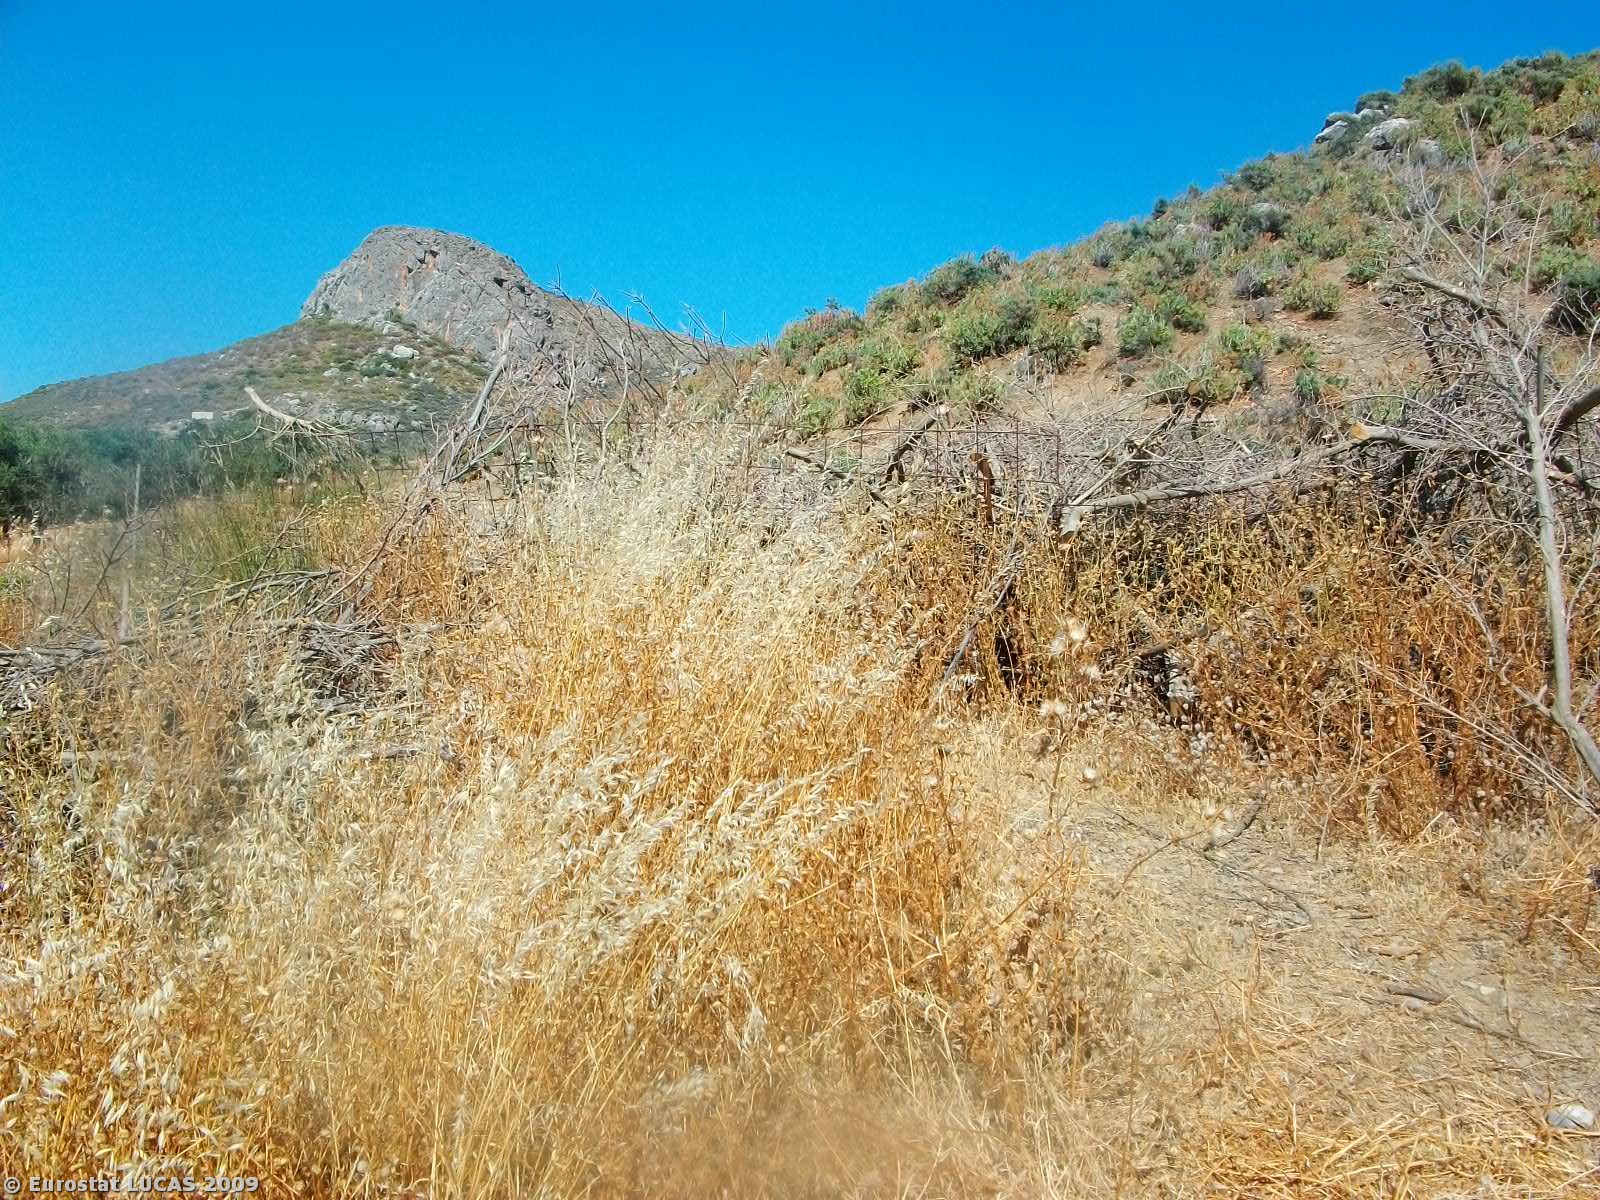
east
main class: Shrubland
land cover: Shrubland with sparse tree cover
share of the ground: > 75 %
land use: Unused
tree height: < 5 m
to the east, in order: Shrubland with sparse tree cover; Rivers and streams; Shrubland with sparse tree cover
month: June
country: GR
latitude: 35.0046
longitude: 24.8749
